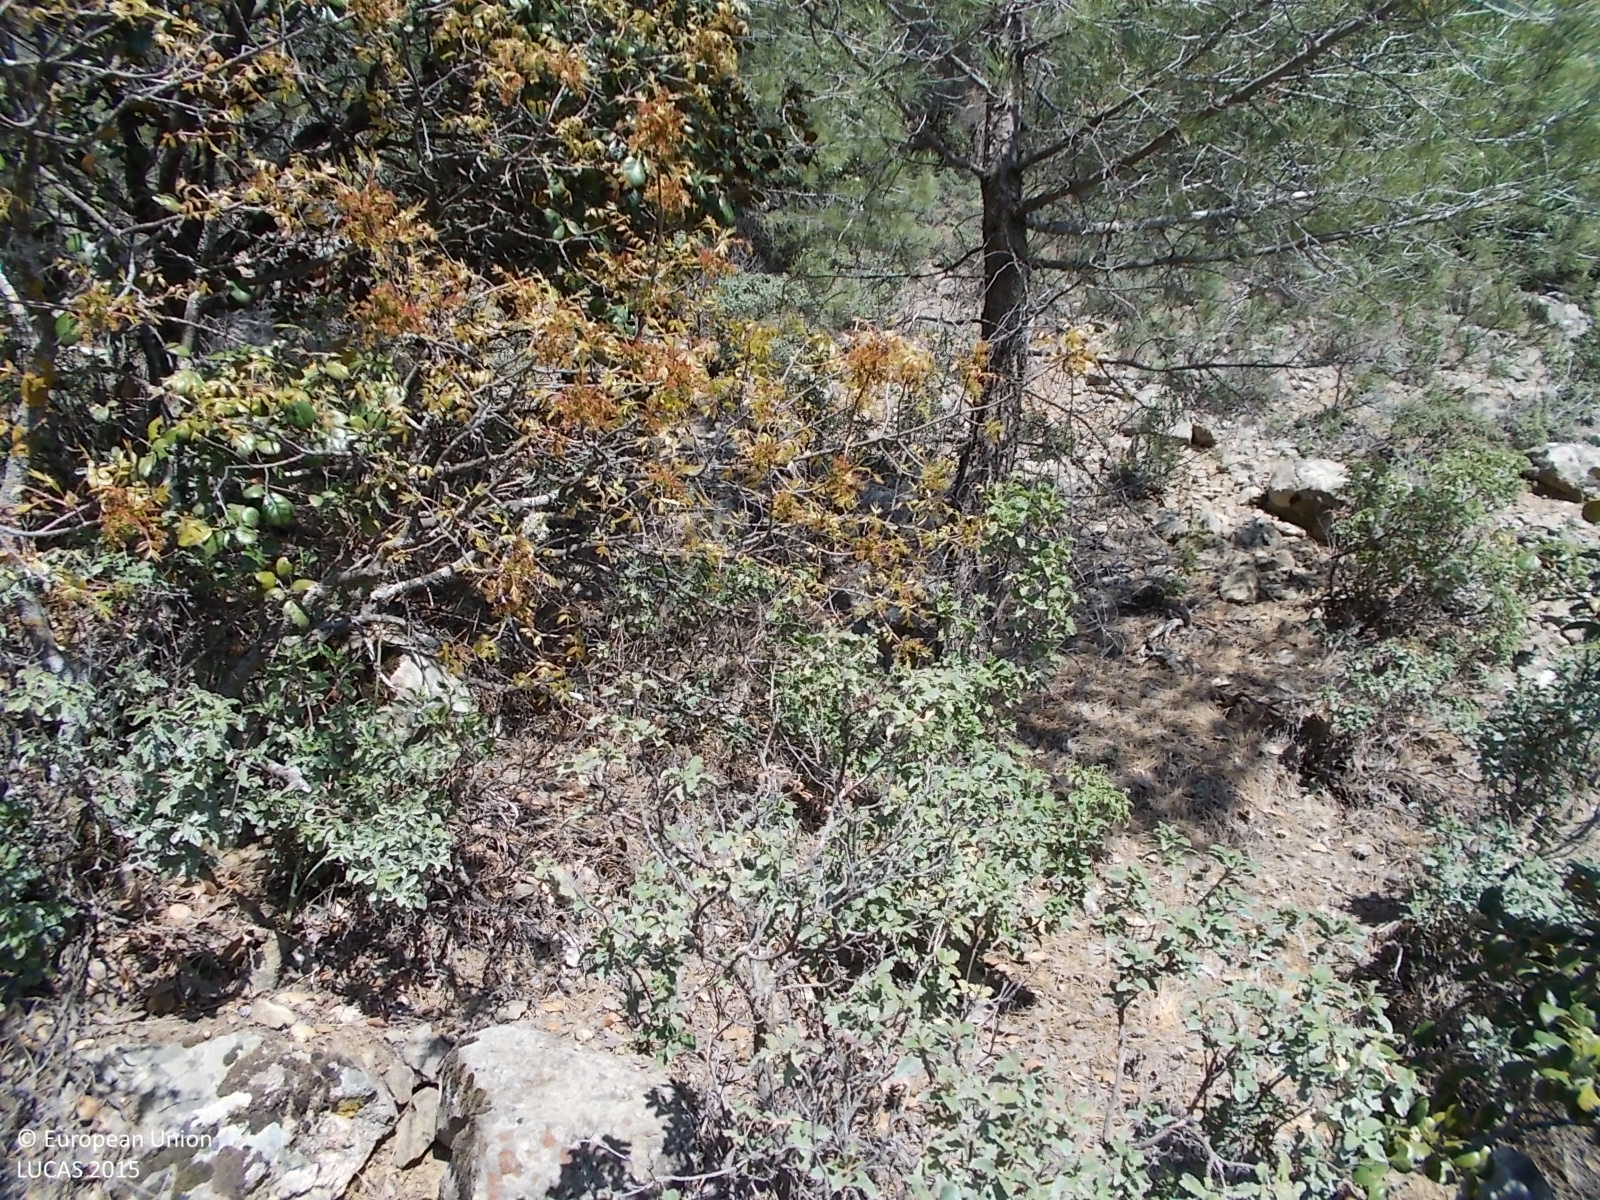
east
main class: Shrubland
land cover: Shrubland with sparse tree cover
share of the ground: > 75 %
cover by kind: shrubs 95 %, broadleaved forest trees 5 %
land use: Semi-natural and natural areas not in use
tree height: > 5 m
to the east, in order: Shrubland with sparse tree cover; Pine dominated mixed woodland; Rocks and stones; Shrubland with sparse tree cover; Pine dominated mixed woodland; Shrubland with sparse tree cover; Pine dominated mixed woodland
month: May
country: CY
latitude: 34.8929
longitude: 33.0532
